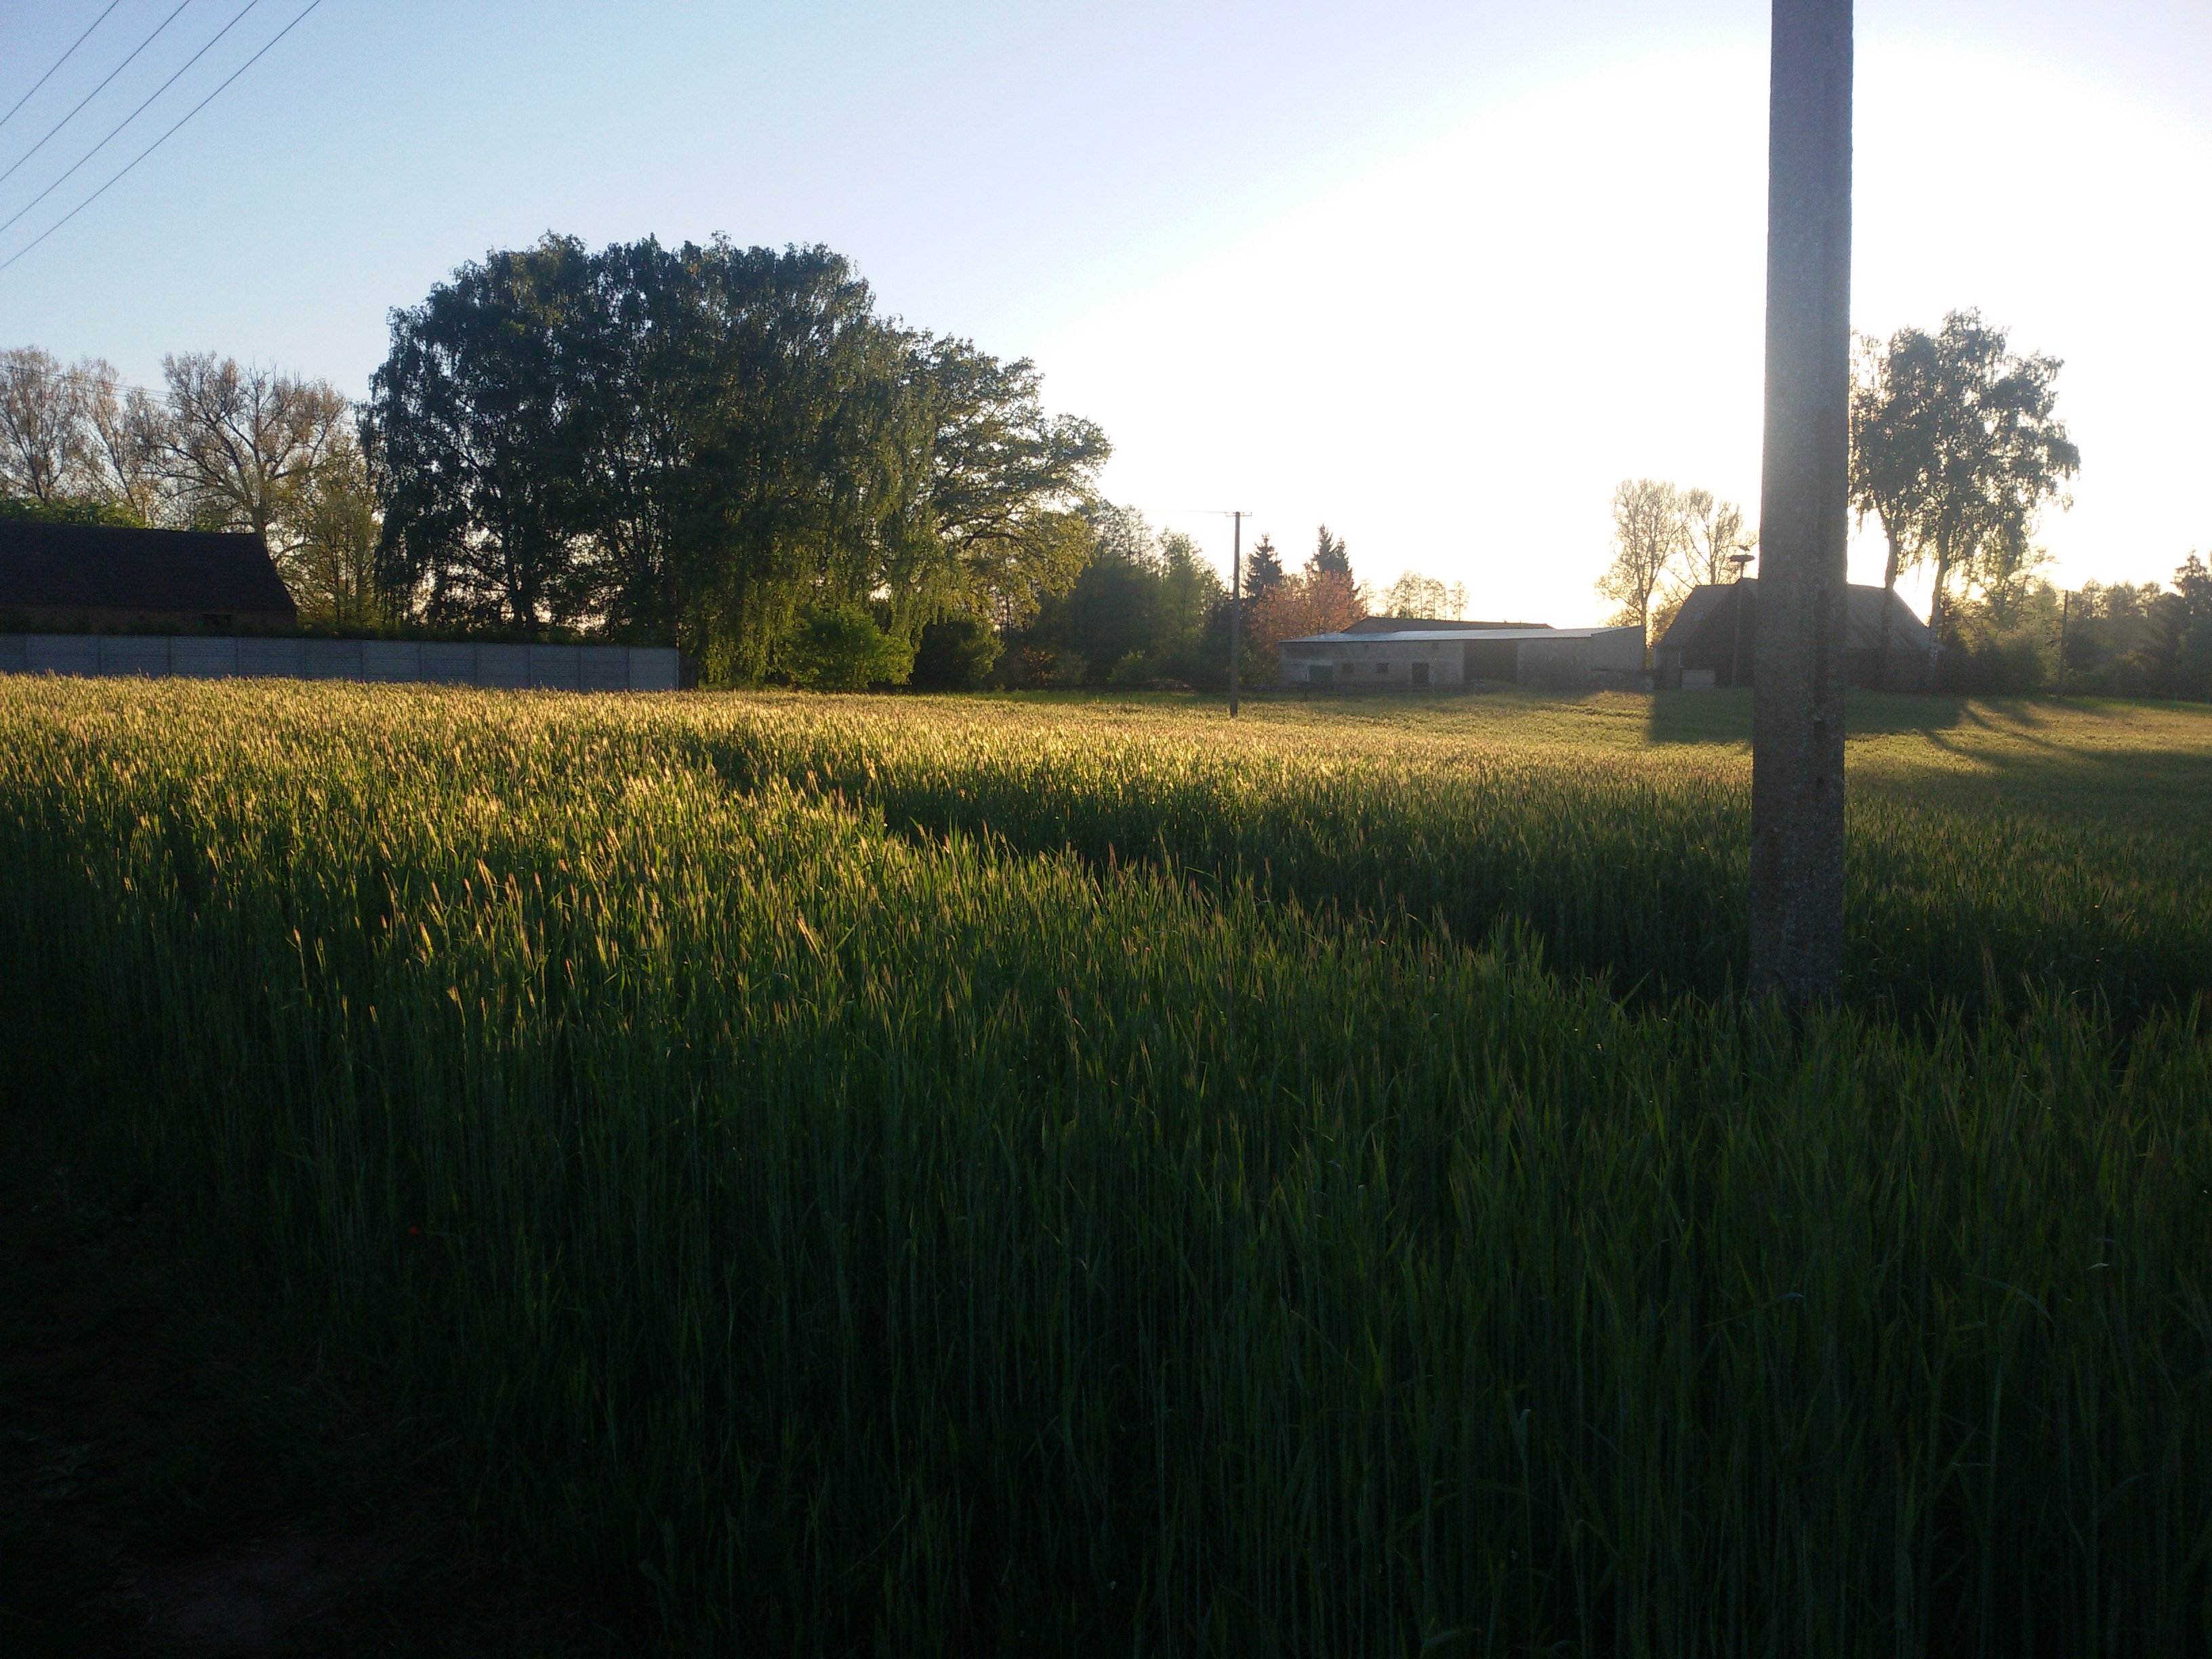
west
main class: Cropland
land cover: Rye
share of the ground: > 75 %
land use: Agriculture (excluding fallow land and kitchen gardens)
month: May
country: PL
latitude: 53.3925
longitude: 17.0922
